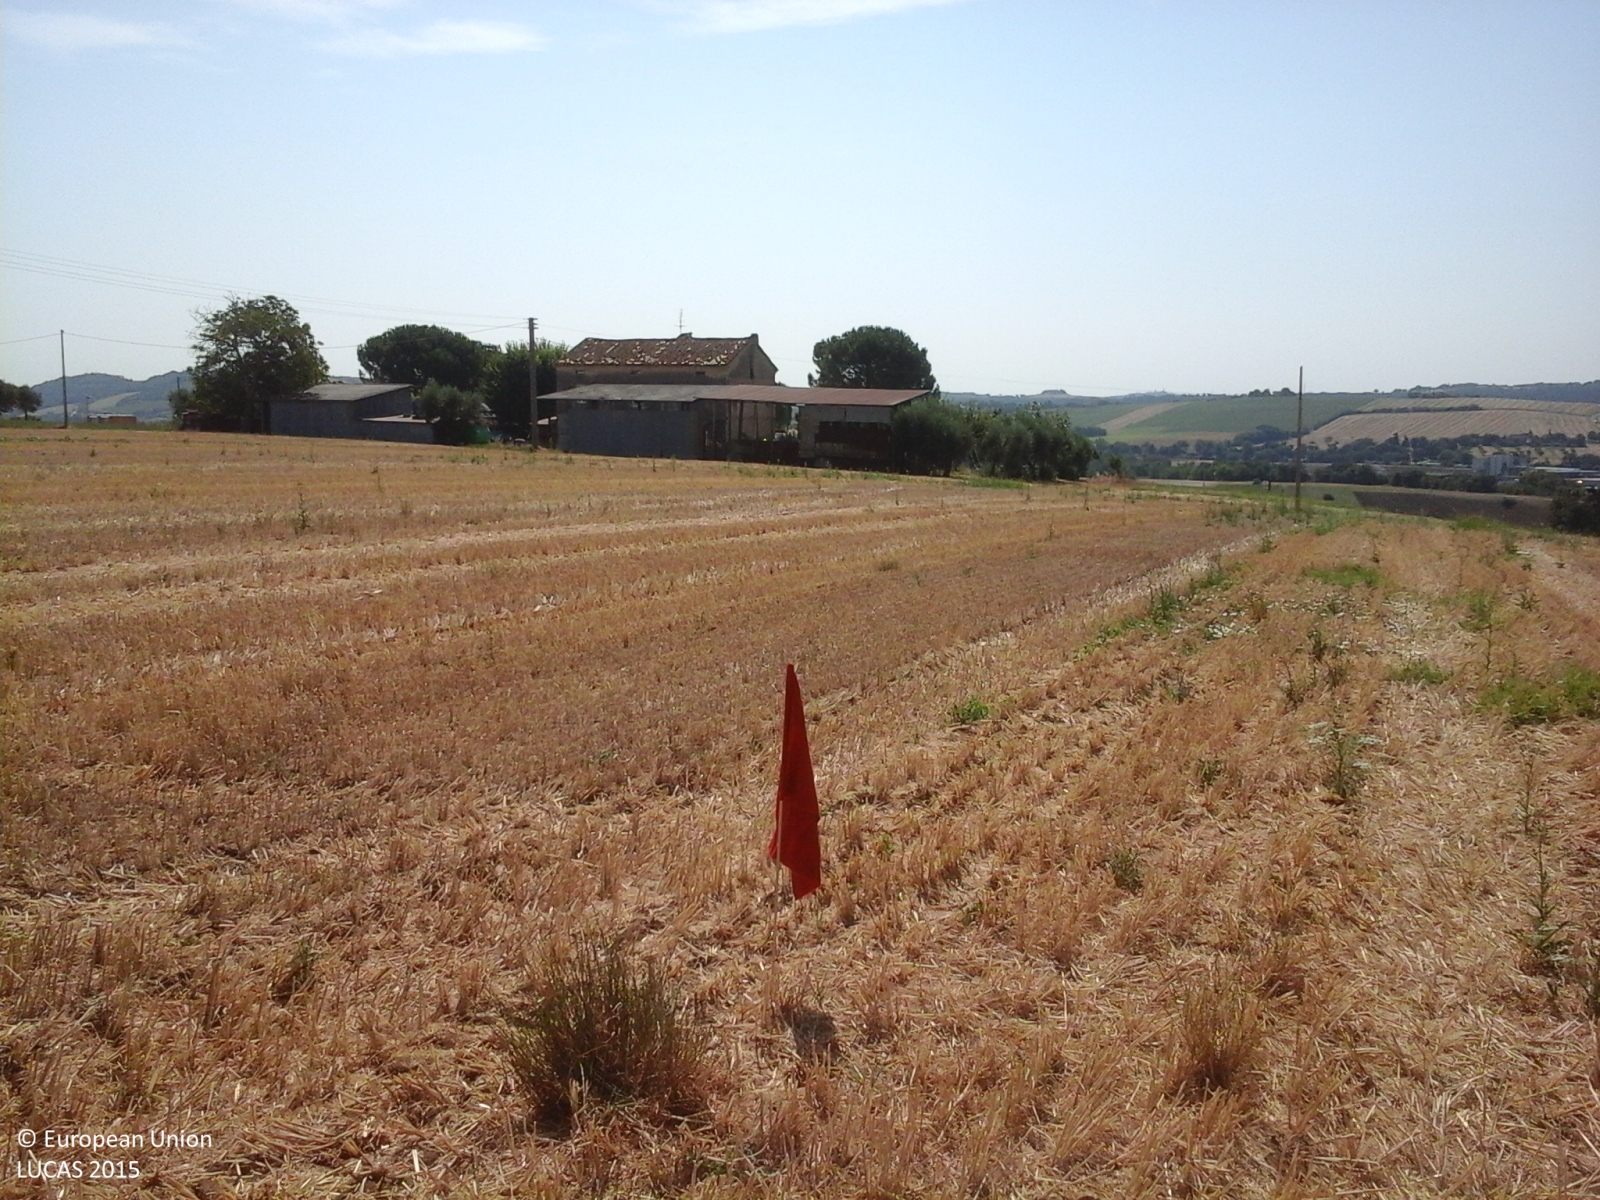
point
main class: Cropland
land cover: Durum wheat
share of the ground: > 75 %
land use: Agriculture (excluding fallow land and kitchen gardens)
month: July
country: IT
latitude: 43.2482
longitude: 13.3782
